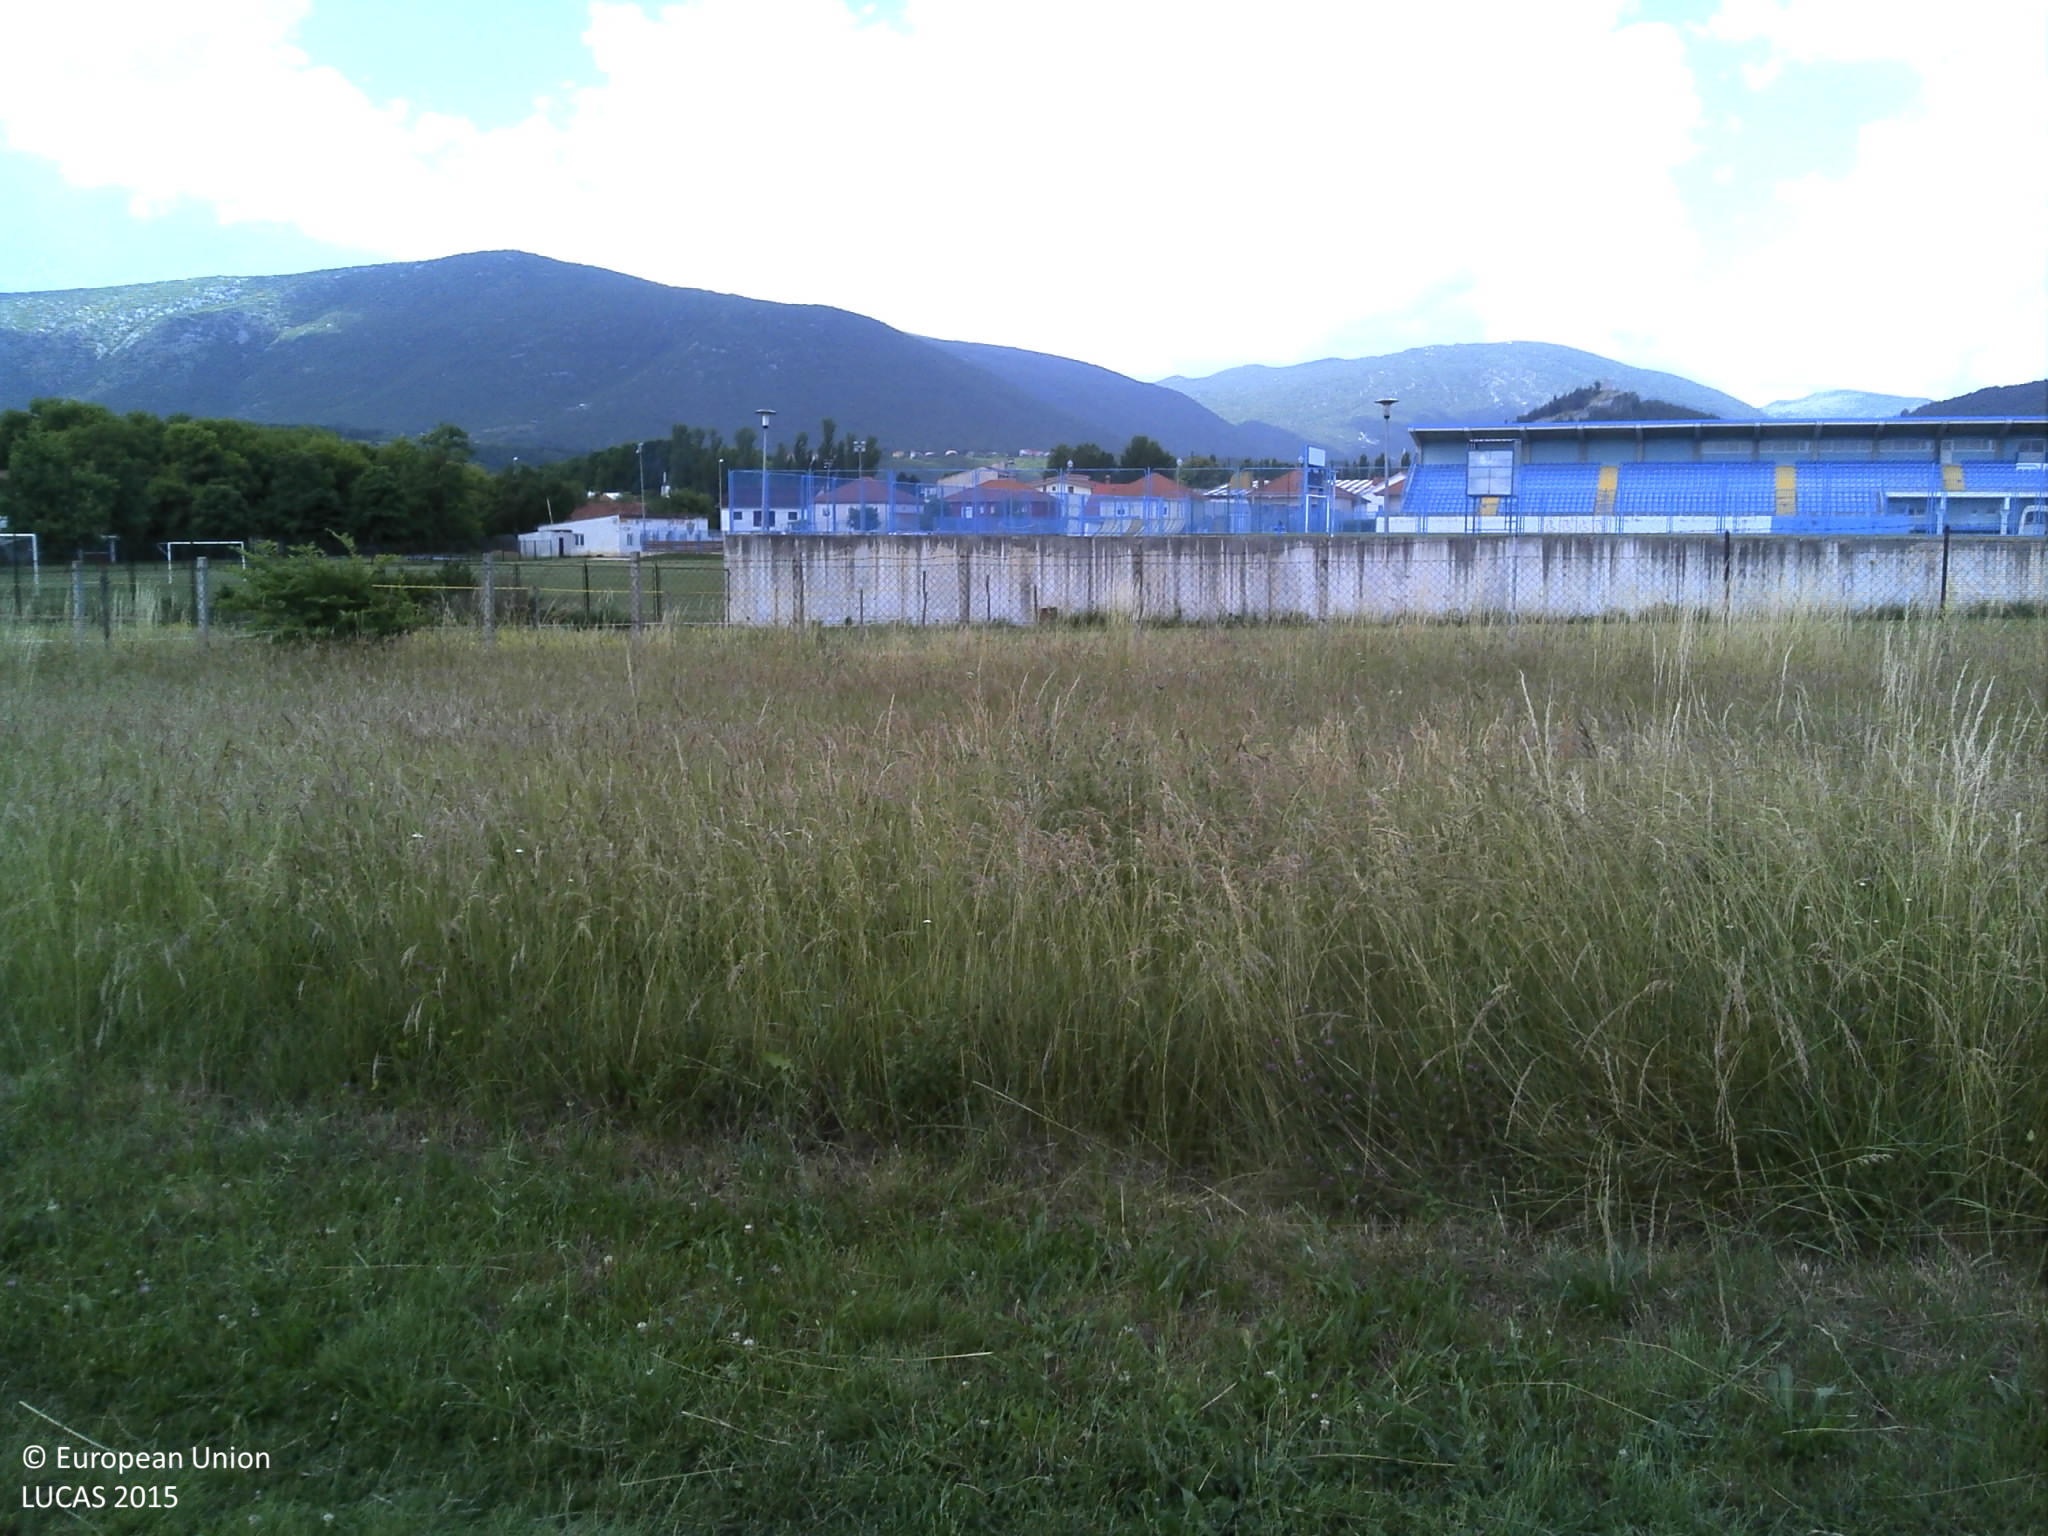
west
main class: Grassland
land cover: Grassland without tree/shrub cover
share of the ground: > 75 %
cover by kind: herbaceous plants 95 %, shrubs 5 %
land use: Agriculture (excluding fallow land and kitchen gardens)
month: June
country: HR
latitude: 43.7025
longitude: 16.6556
